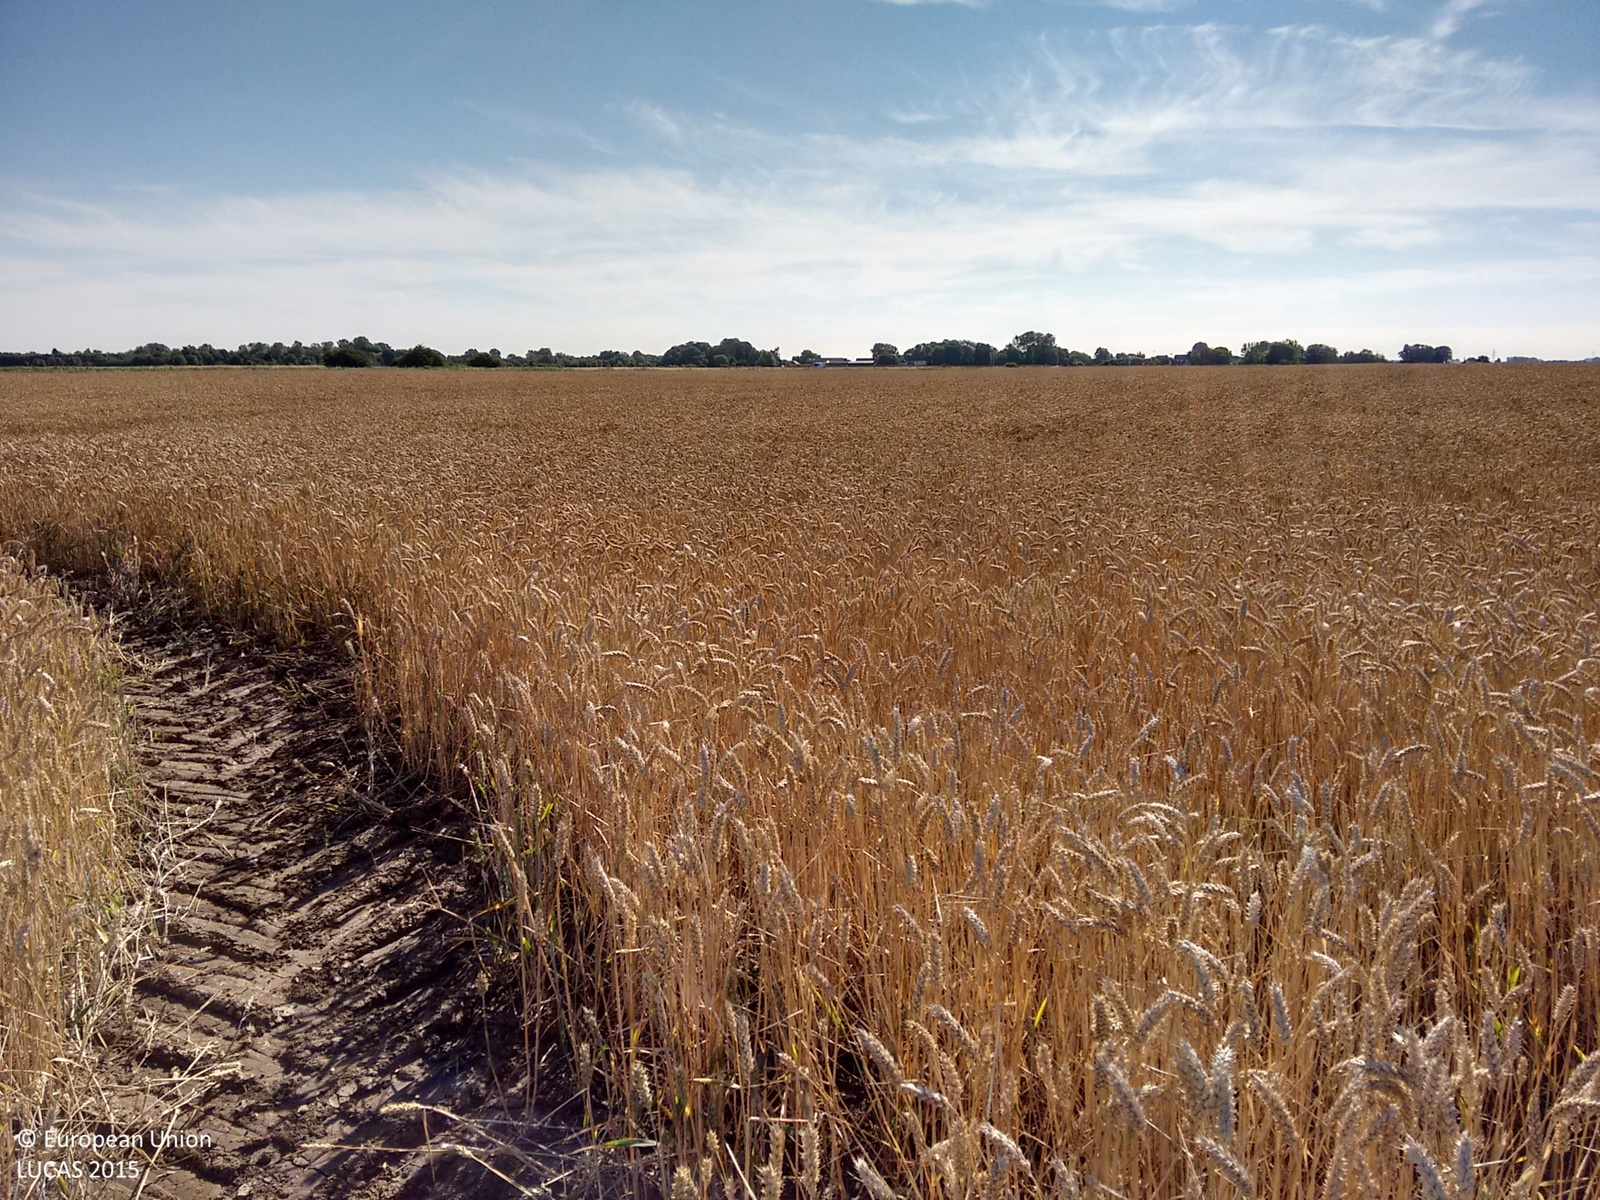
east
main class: Cropland
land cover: Common wheat
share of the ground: > 75 %
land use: Agriculture (excluding fallow land and kitchen gardens)
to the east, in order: Common wheat
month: July
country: GB
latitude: 52.6979
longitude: 0.0090
